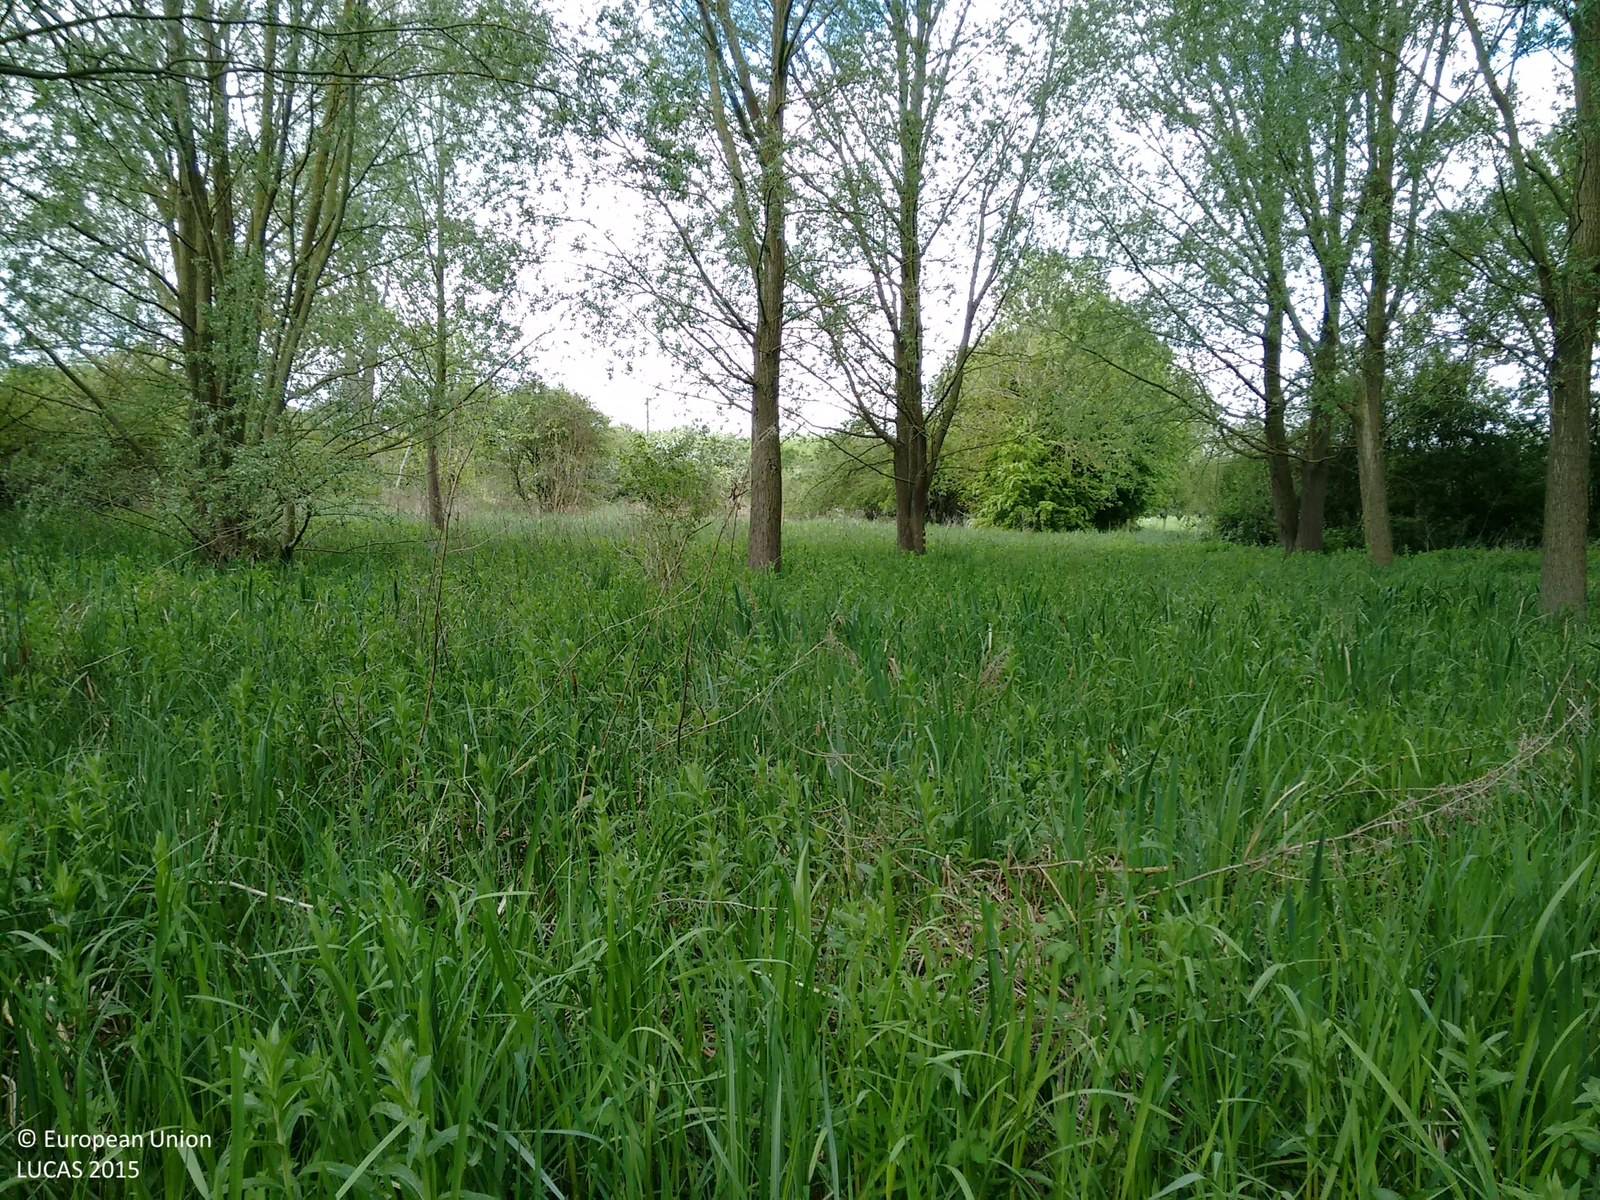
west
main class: Woodland
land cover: Broadleaved woodland
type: mesophytic deciduous forest
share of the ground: > 75 %
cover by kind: broadleaved forest trees 80 %, herbaceous plants 20 %
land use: Forestry
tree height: > 5 m
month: May
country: GB
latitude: 52.1626
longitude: -0.5202
